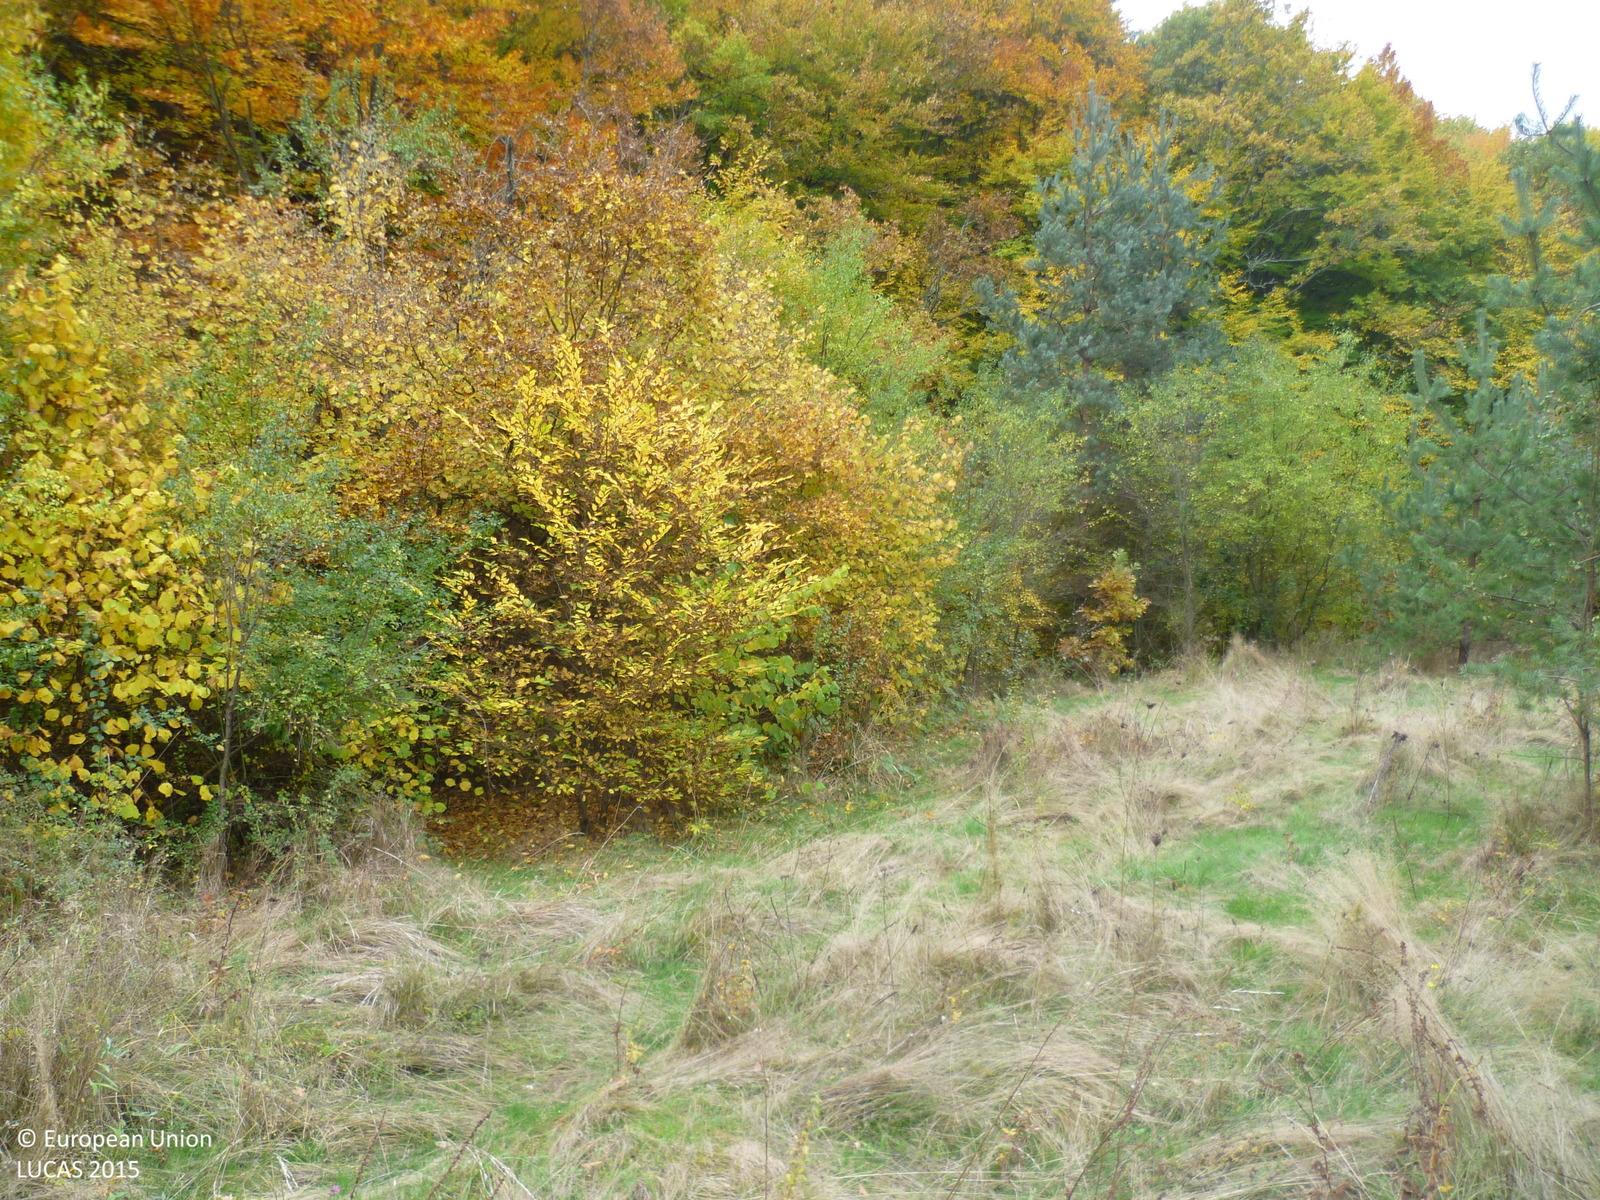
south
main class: Grassland
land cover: Grassland with sparse tree/shrub cover
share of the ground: > 75 %
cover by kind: herbaceous plants 90 %, coniferous forest trees 5 %, shrubs 5 %
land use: Semi-natural and natural areas not in use
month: October
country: BG
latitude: 42.5139
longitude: 23.6323
